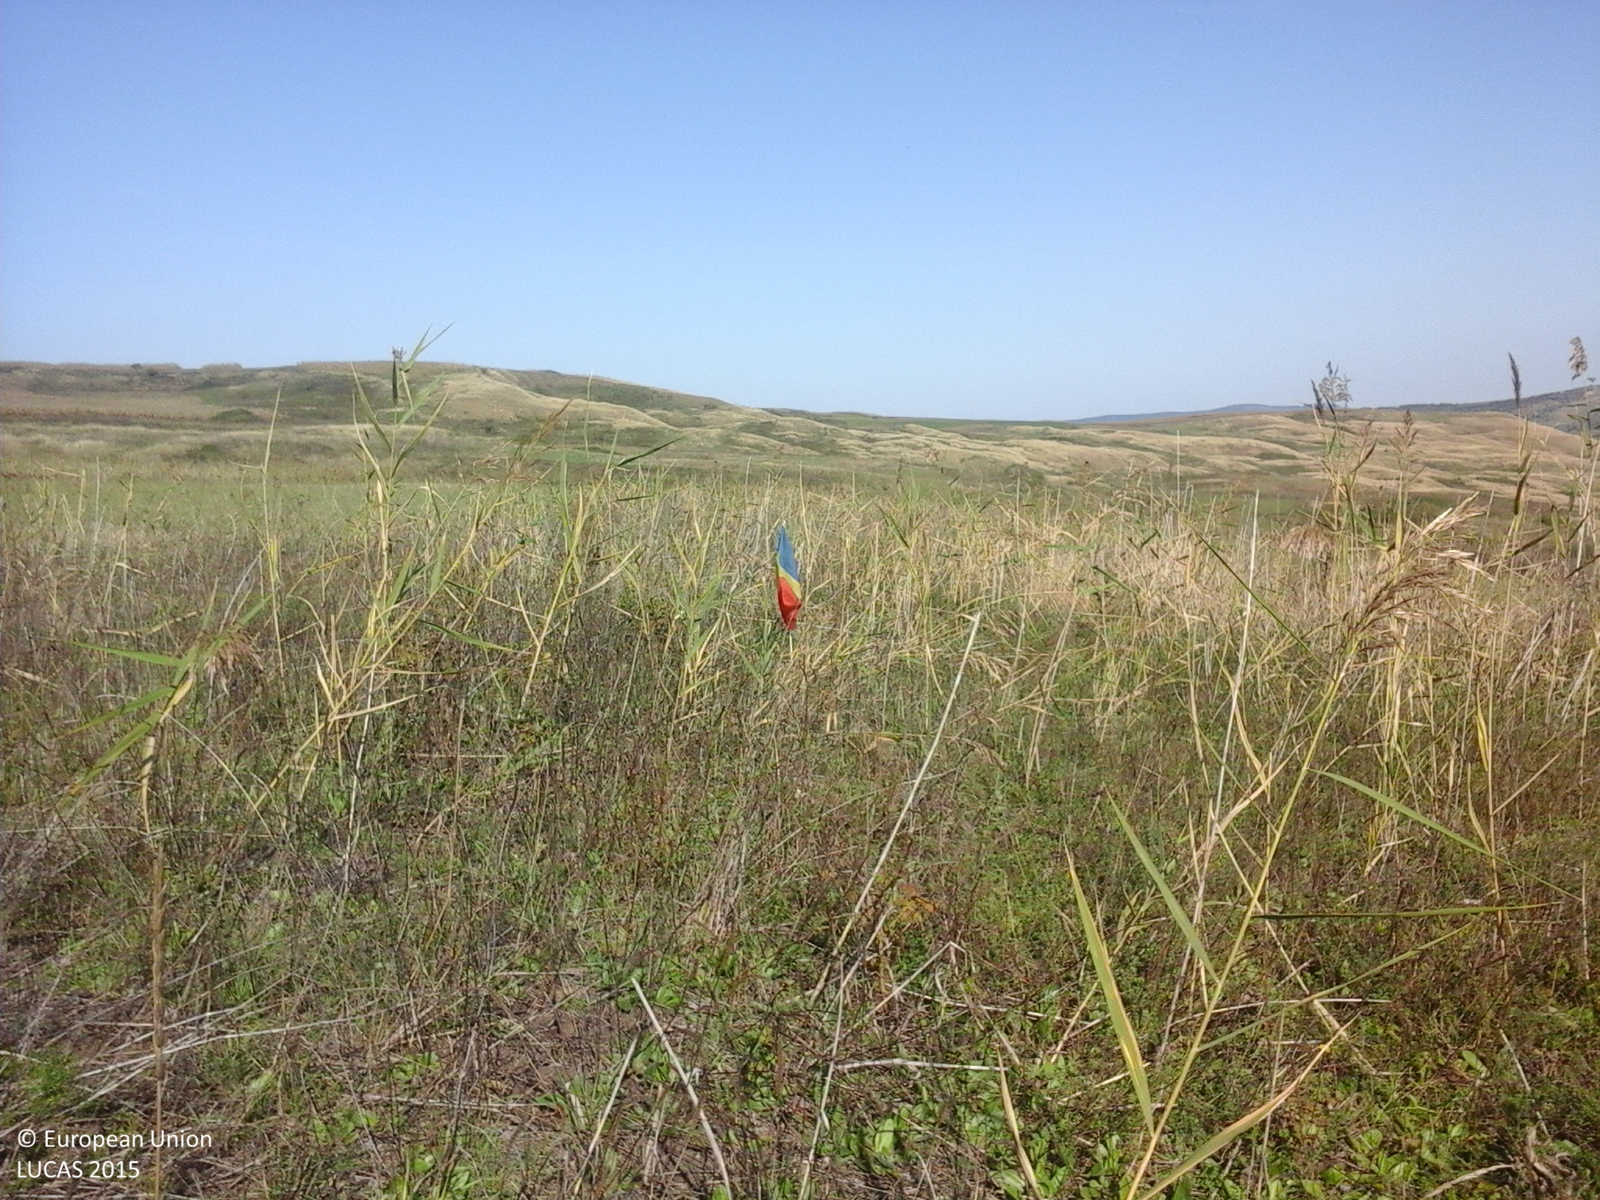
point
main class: Grassland
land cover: Spontaneously vegetated surfaces
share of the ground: > 75 %
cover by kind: herbaceous plants 100 %
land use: Fallow land
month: October
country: RO
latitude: 46.1369
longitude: 23.7257
